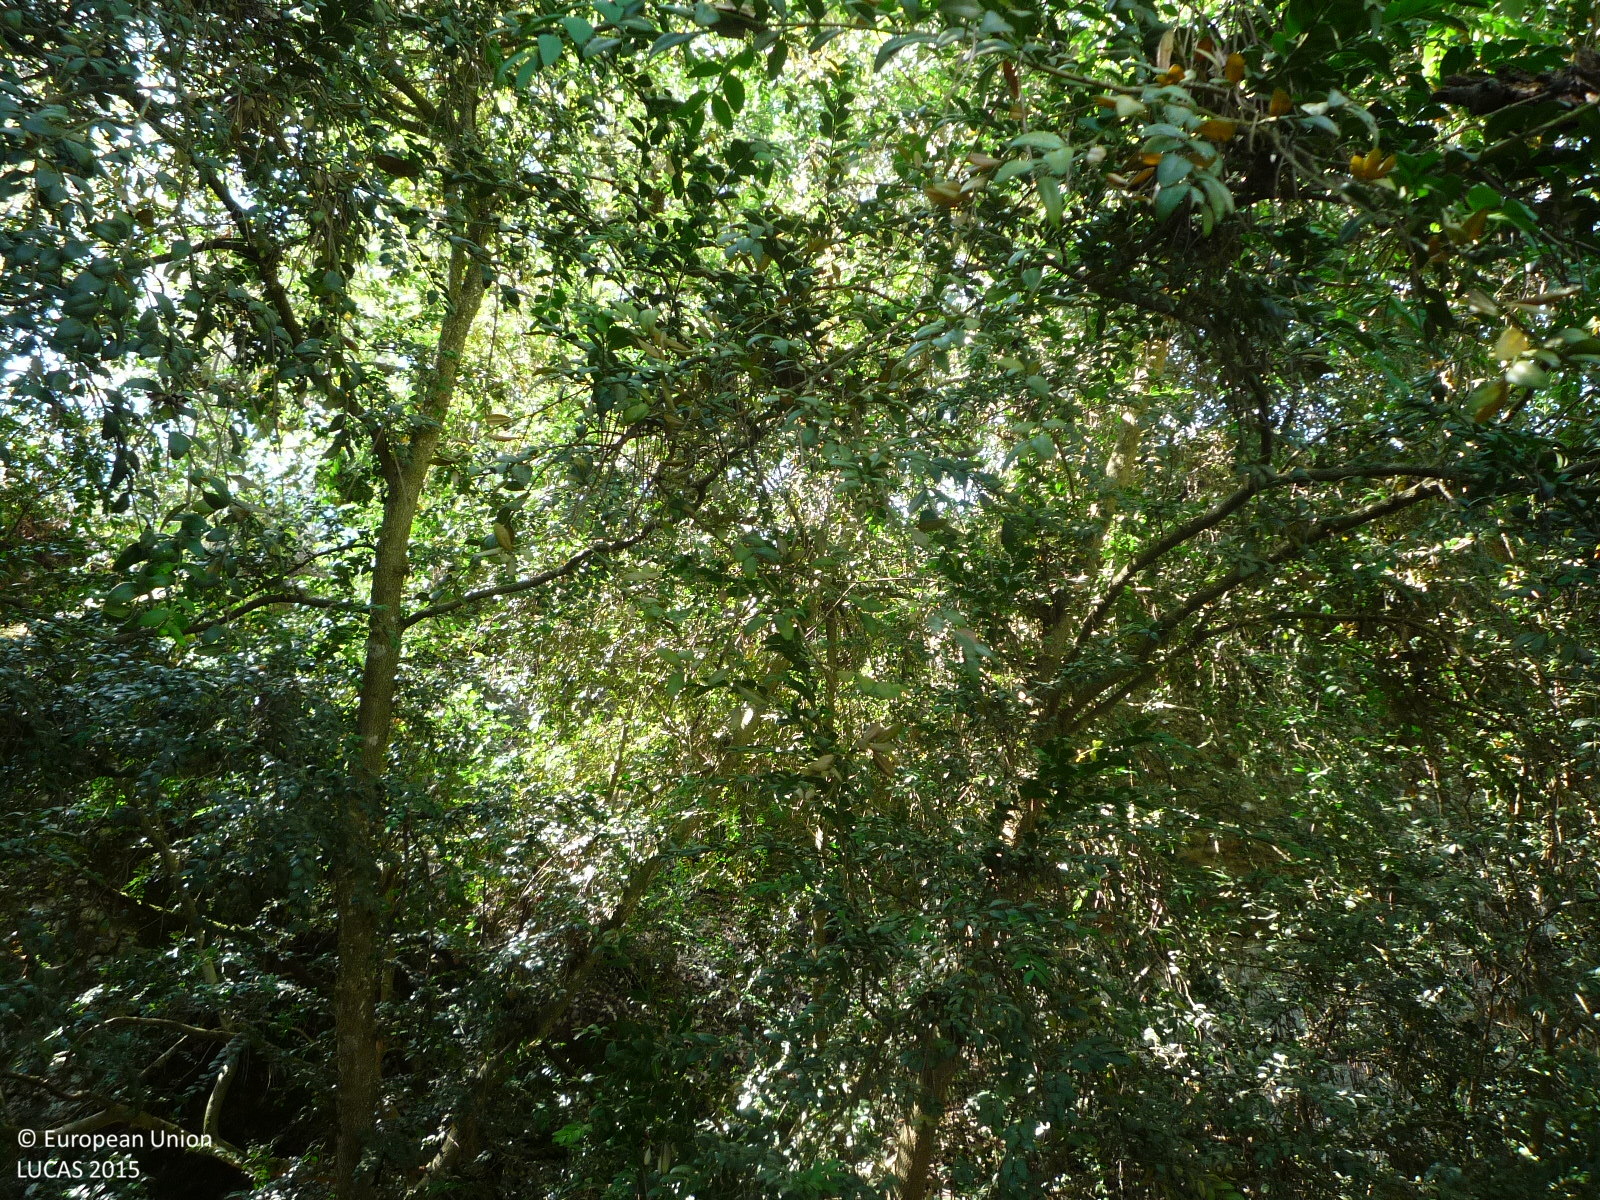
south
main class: Woodland
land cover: Other mixed woodland
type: broadleaved evergreen forest
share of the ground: > 75 %
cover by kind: broadleaved forest trees 50 %, coniferous forest trees 25 %, shrubs 25 %
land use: Semi-natural and natural areas not in use
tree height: > 5 m
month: June
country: ES
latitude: 41.7362
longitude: 1.9719
